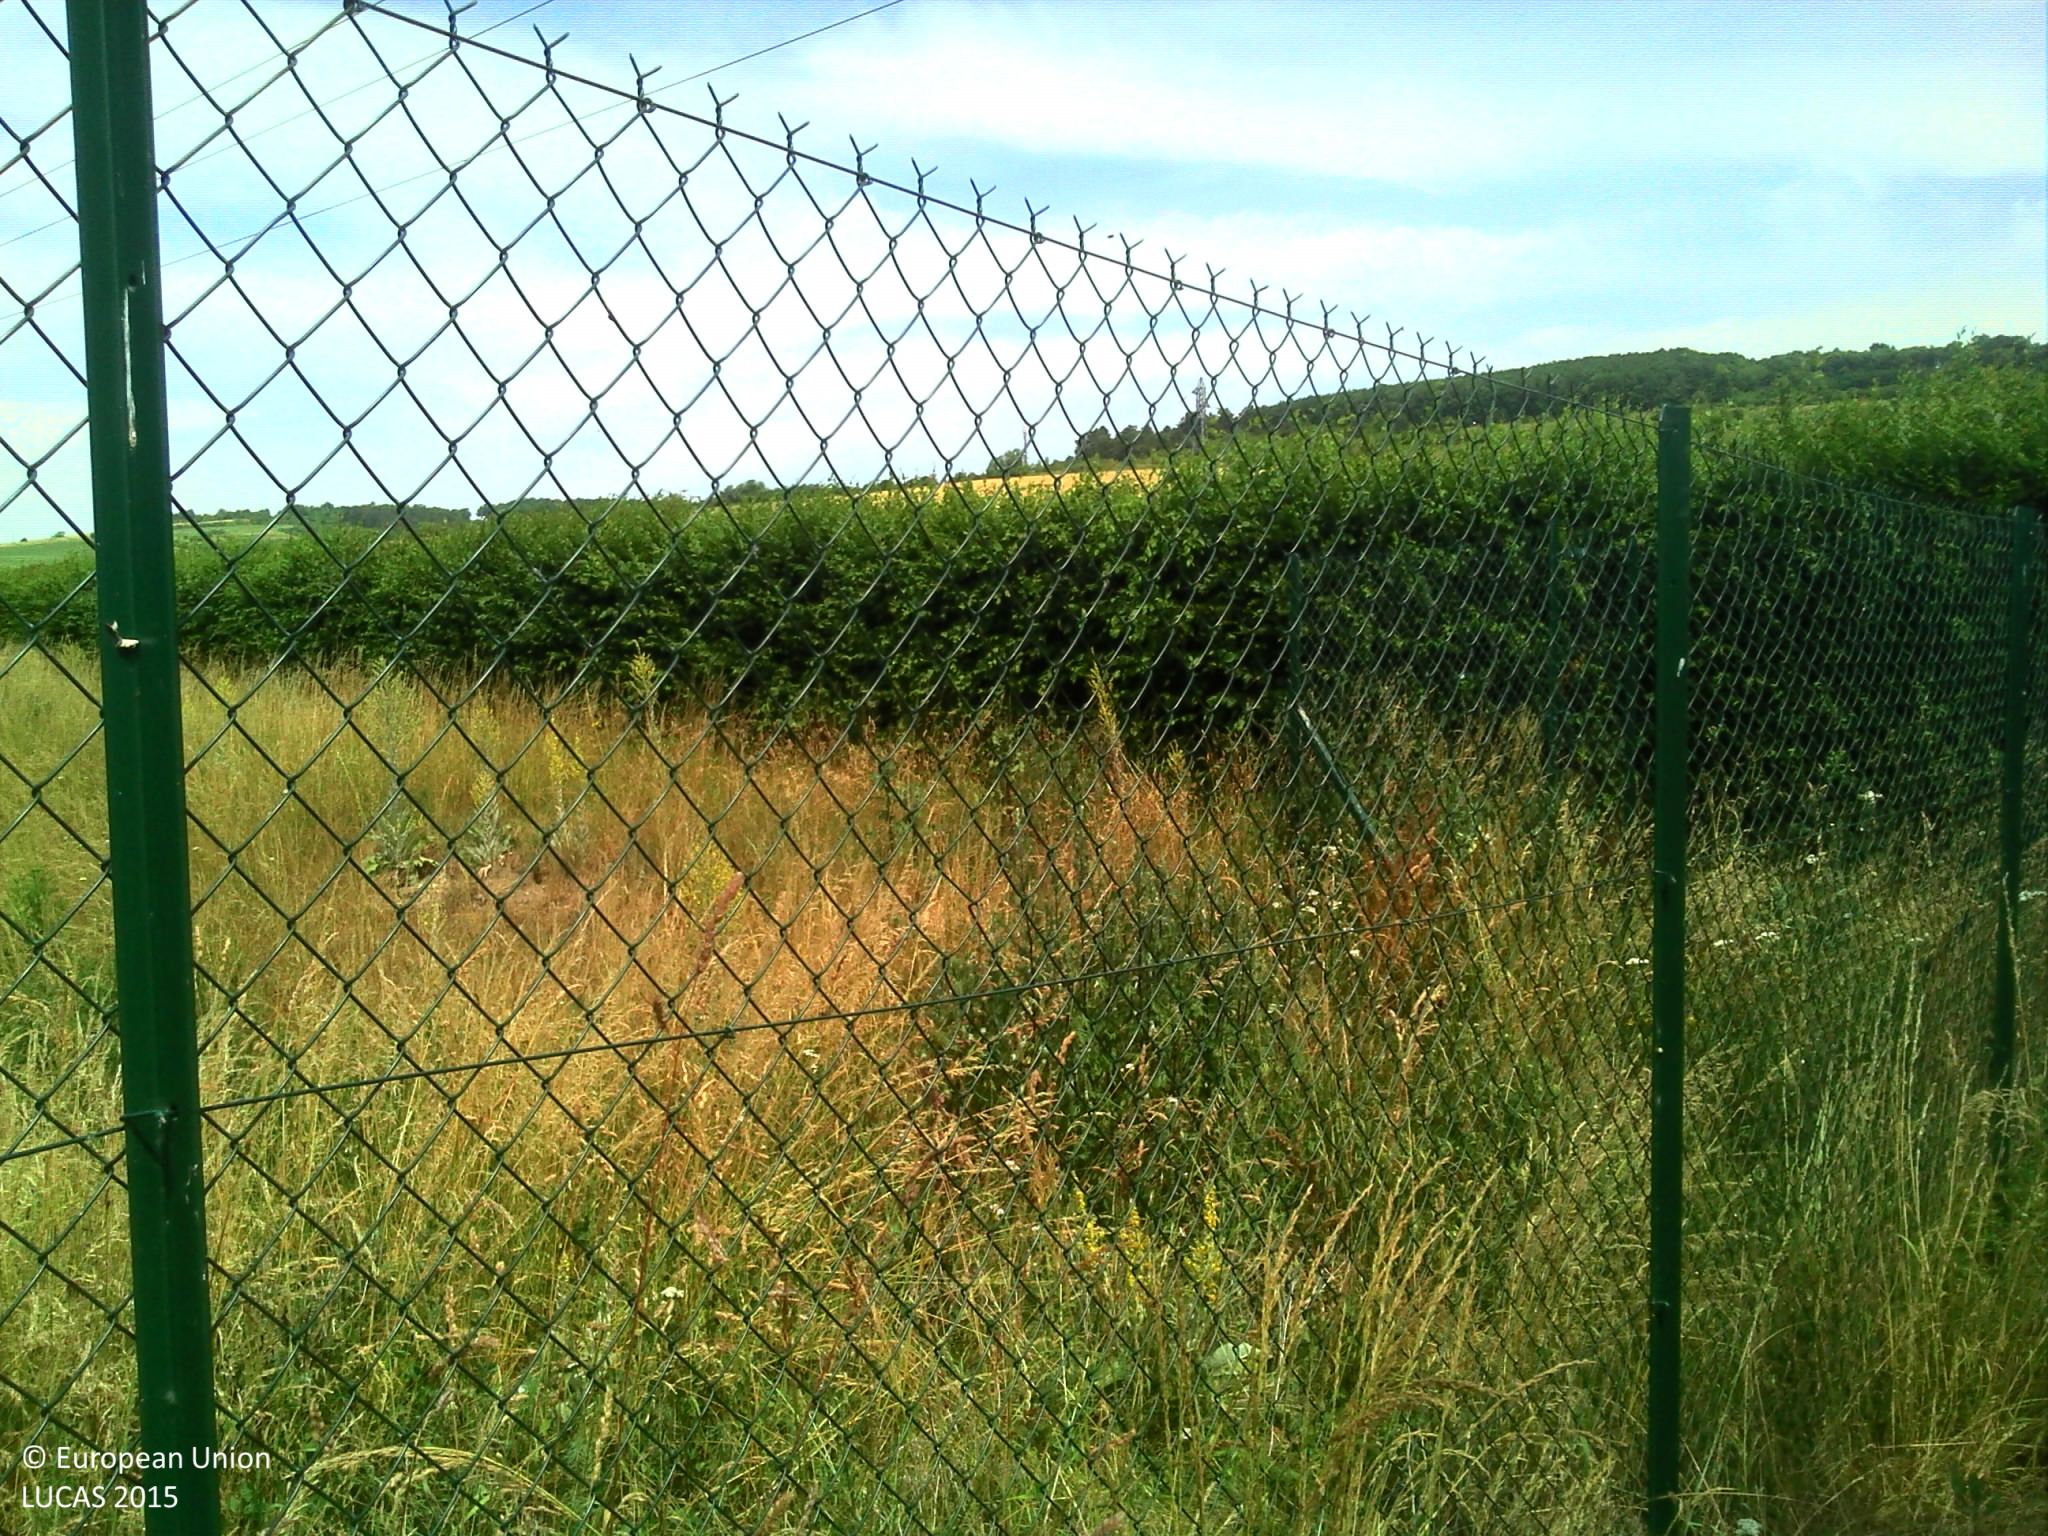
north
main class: Grassland
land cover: Spontaneously vegetated surfaces
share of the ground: > 75 %
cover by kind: herbaceous plants 95 %, shrubs 5 %
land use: Waste treatment
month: June
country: FR
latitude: 49.1060
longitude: 1.2546
